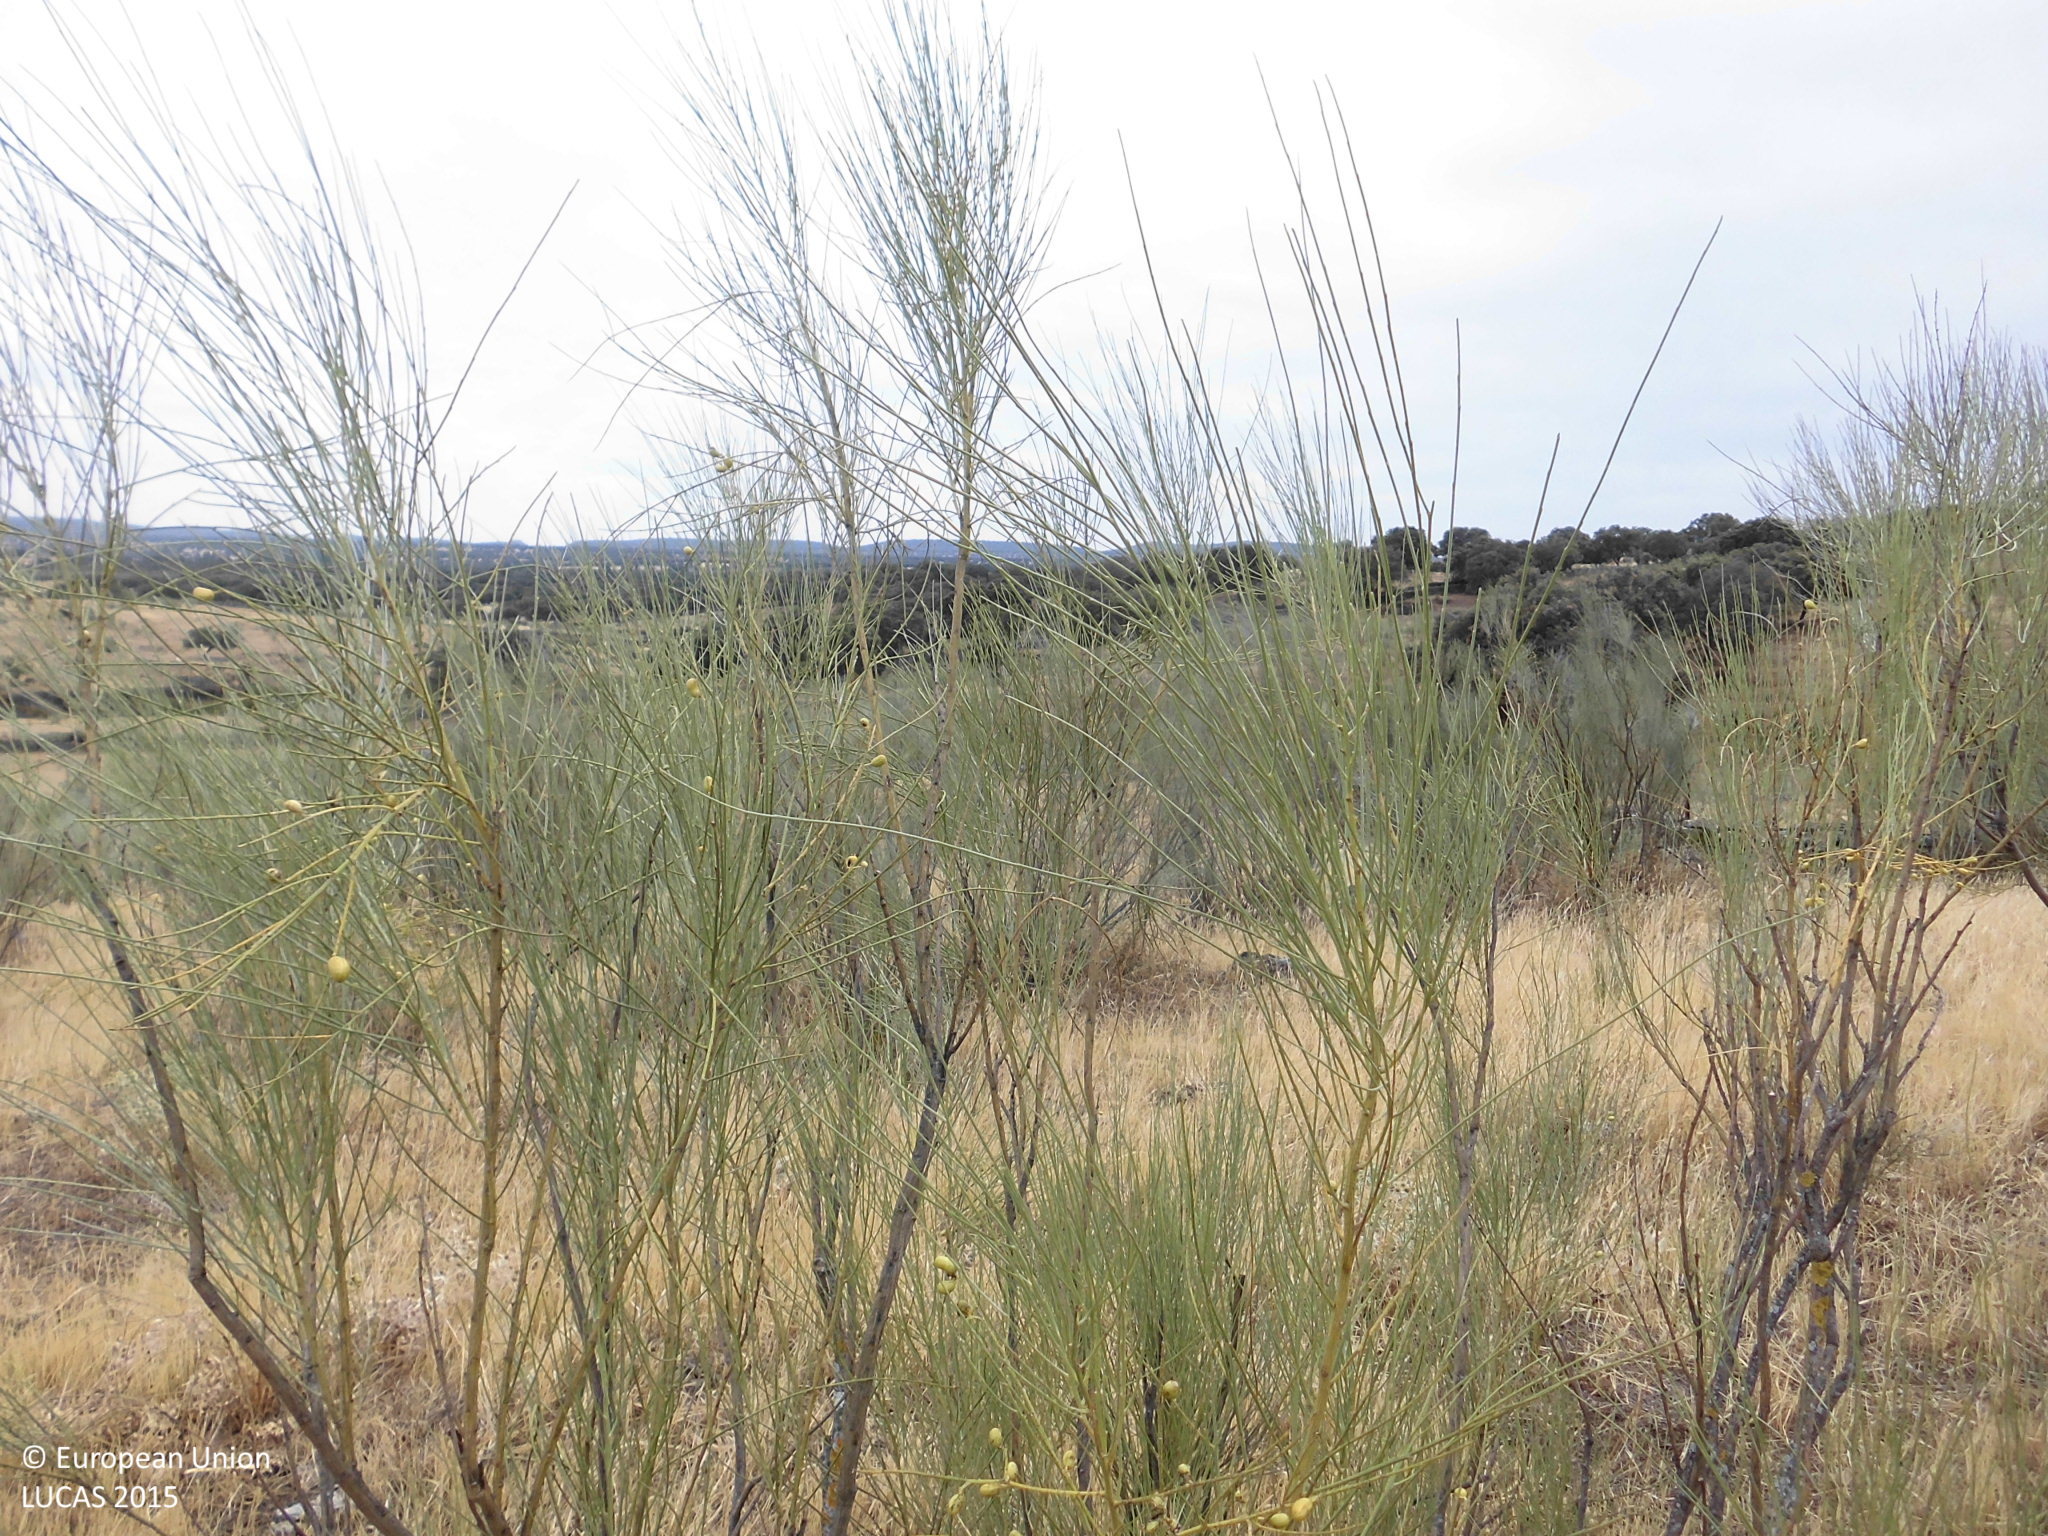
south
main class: Shrubland
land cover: Shrubland without tree cover
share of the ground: 10 - 25 %
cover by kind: herbaceous plants 75 %, shrubs 20 %, consolidated bare surface 5 %
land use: Agriculture (excluding fallow land and kitchen gardens)
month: July
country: ES
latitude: 39.8934
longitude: -6.4856
